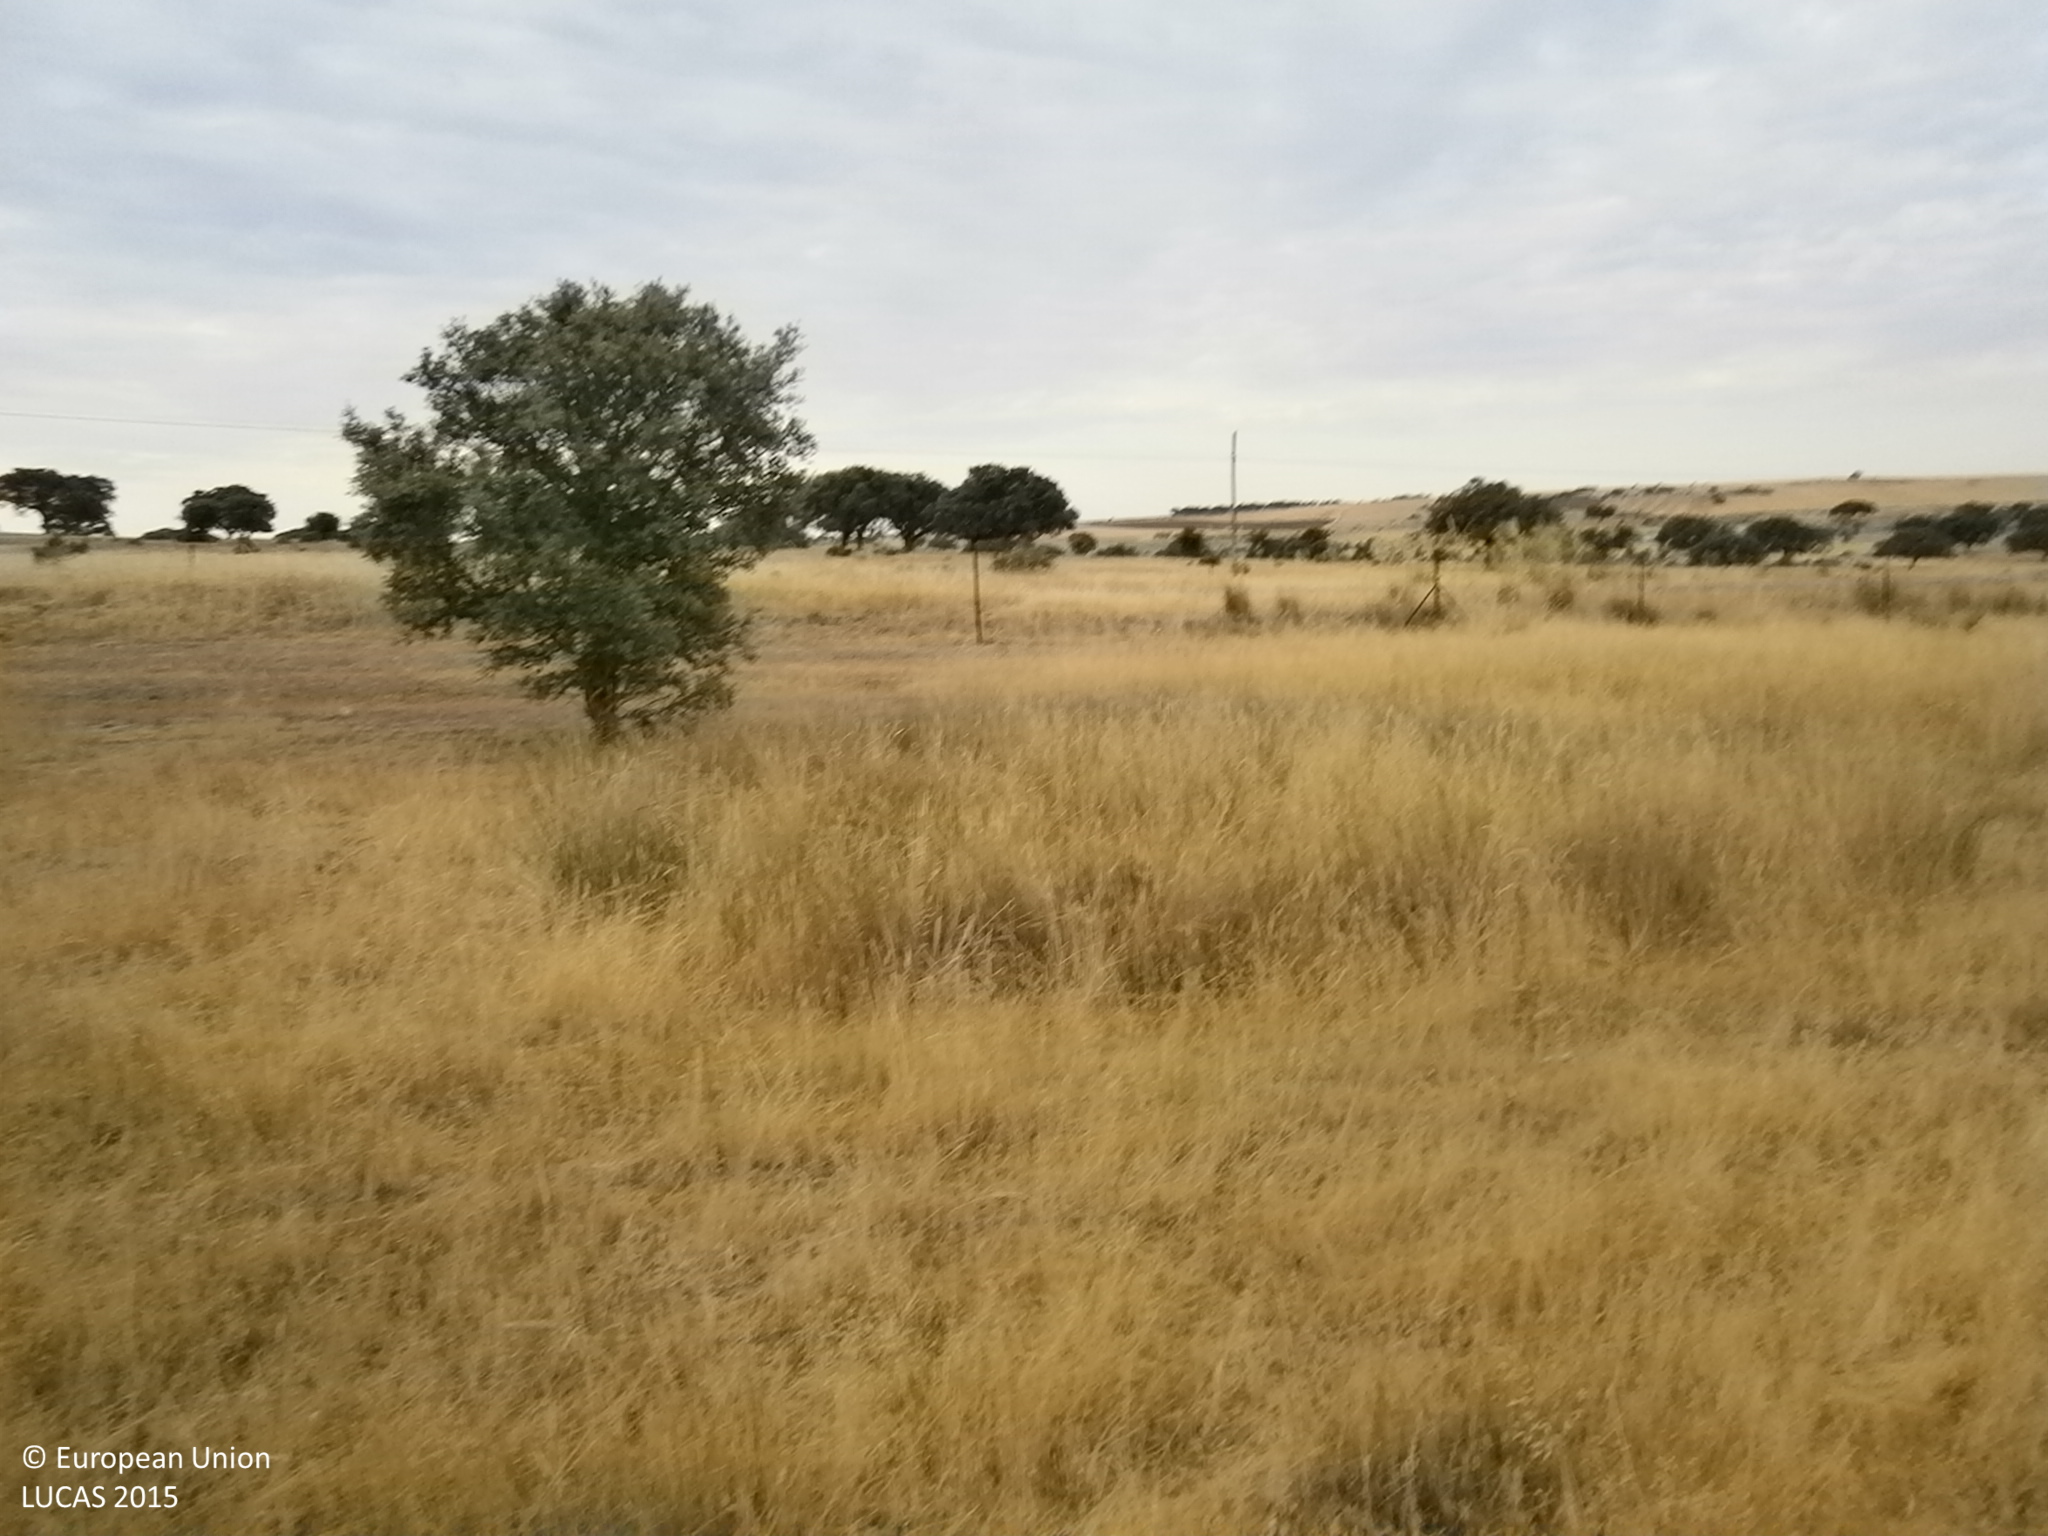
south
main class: Grassland
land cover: Grassland with sparse tree/shrub cover
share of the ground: > 75 %
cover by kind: herbaceous plants 90 %, broadleaved forest trees 5 %, shrubs 5 %
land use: Sport
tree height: > 5 m
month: June
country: ES
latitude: 38.9819
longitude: -6.3236
